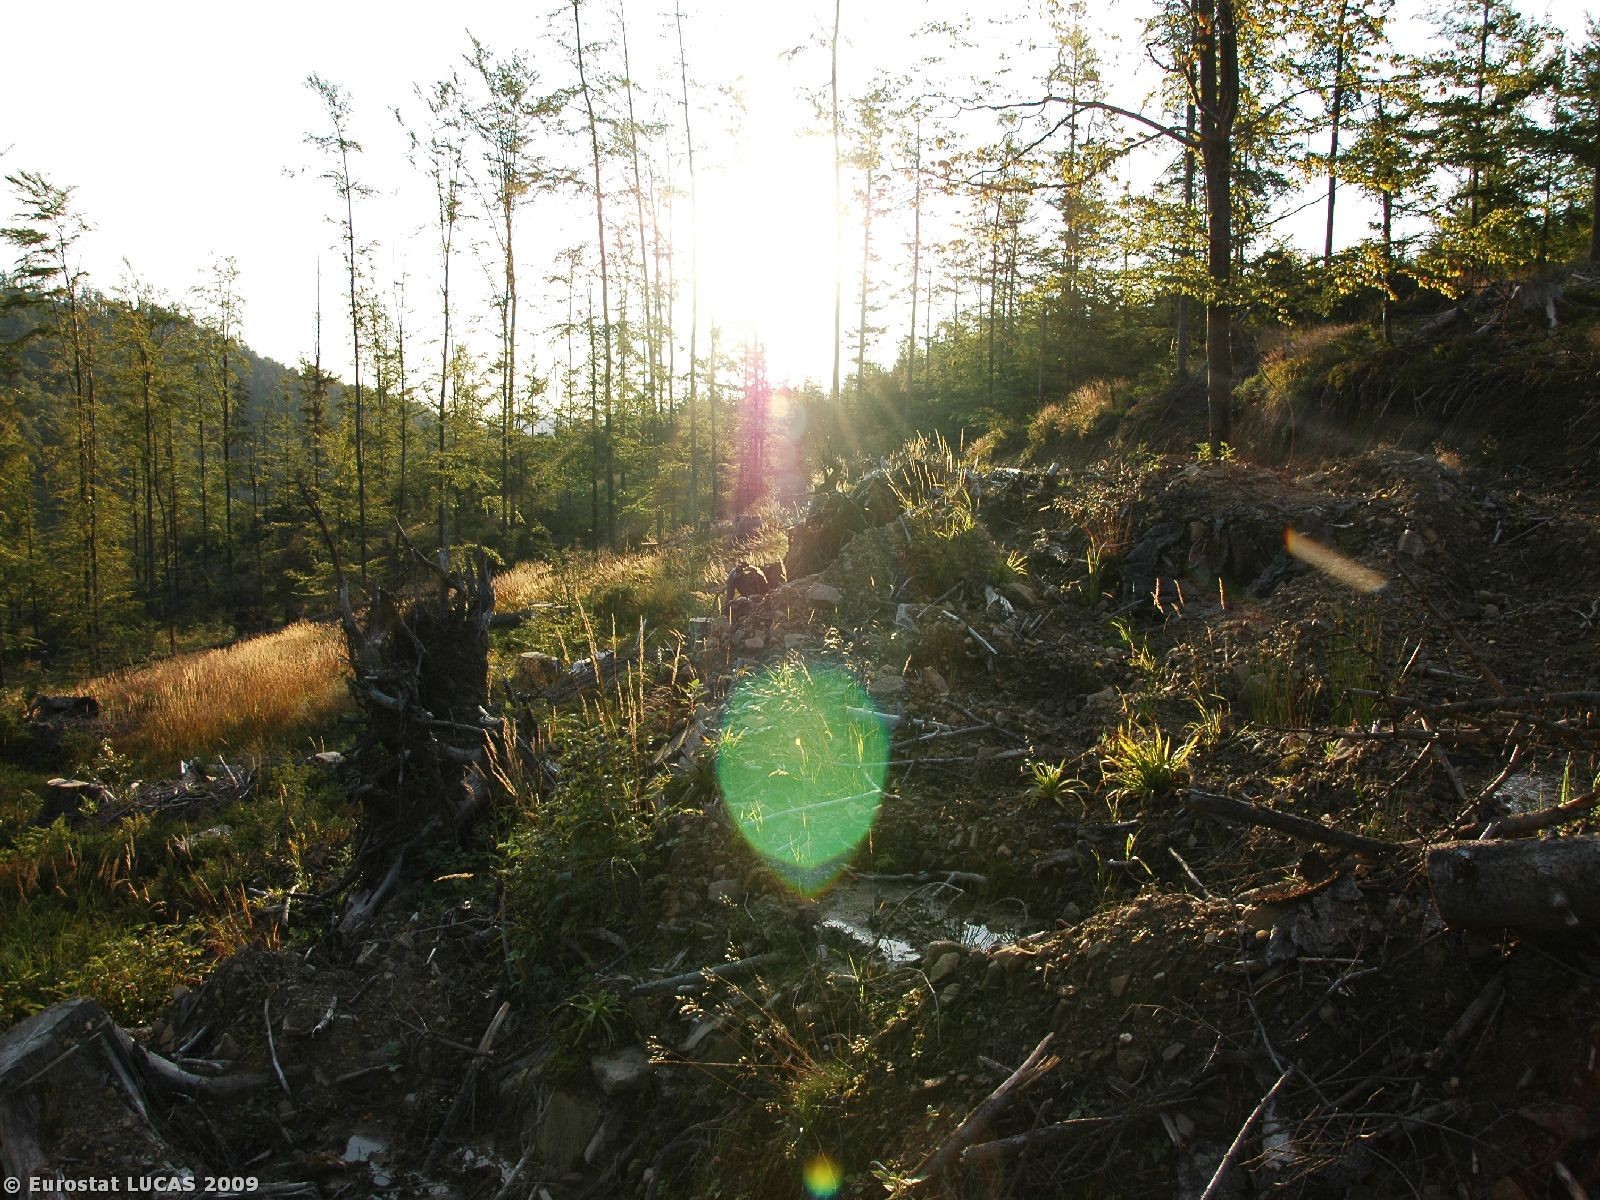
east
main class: Bare land
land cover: Bare land
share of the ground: > 75 %
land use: Forestry
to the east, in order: Bare land; Tracks; Mixed woodland; Coniferous woodland; Tracks; Coniferous woodland
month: September
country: PL
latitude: 49.6459
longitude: 19.0108
